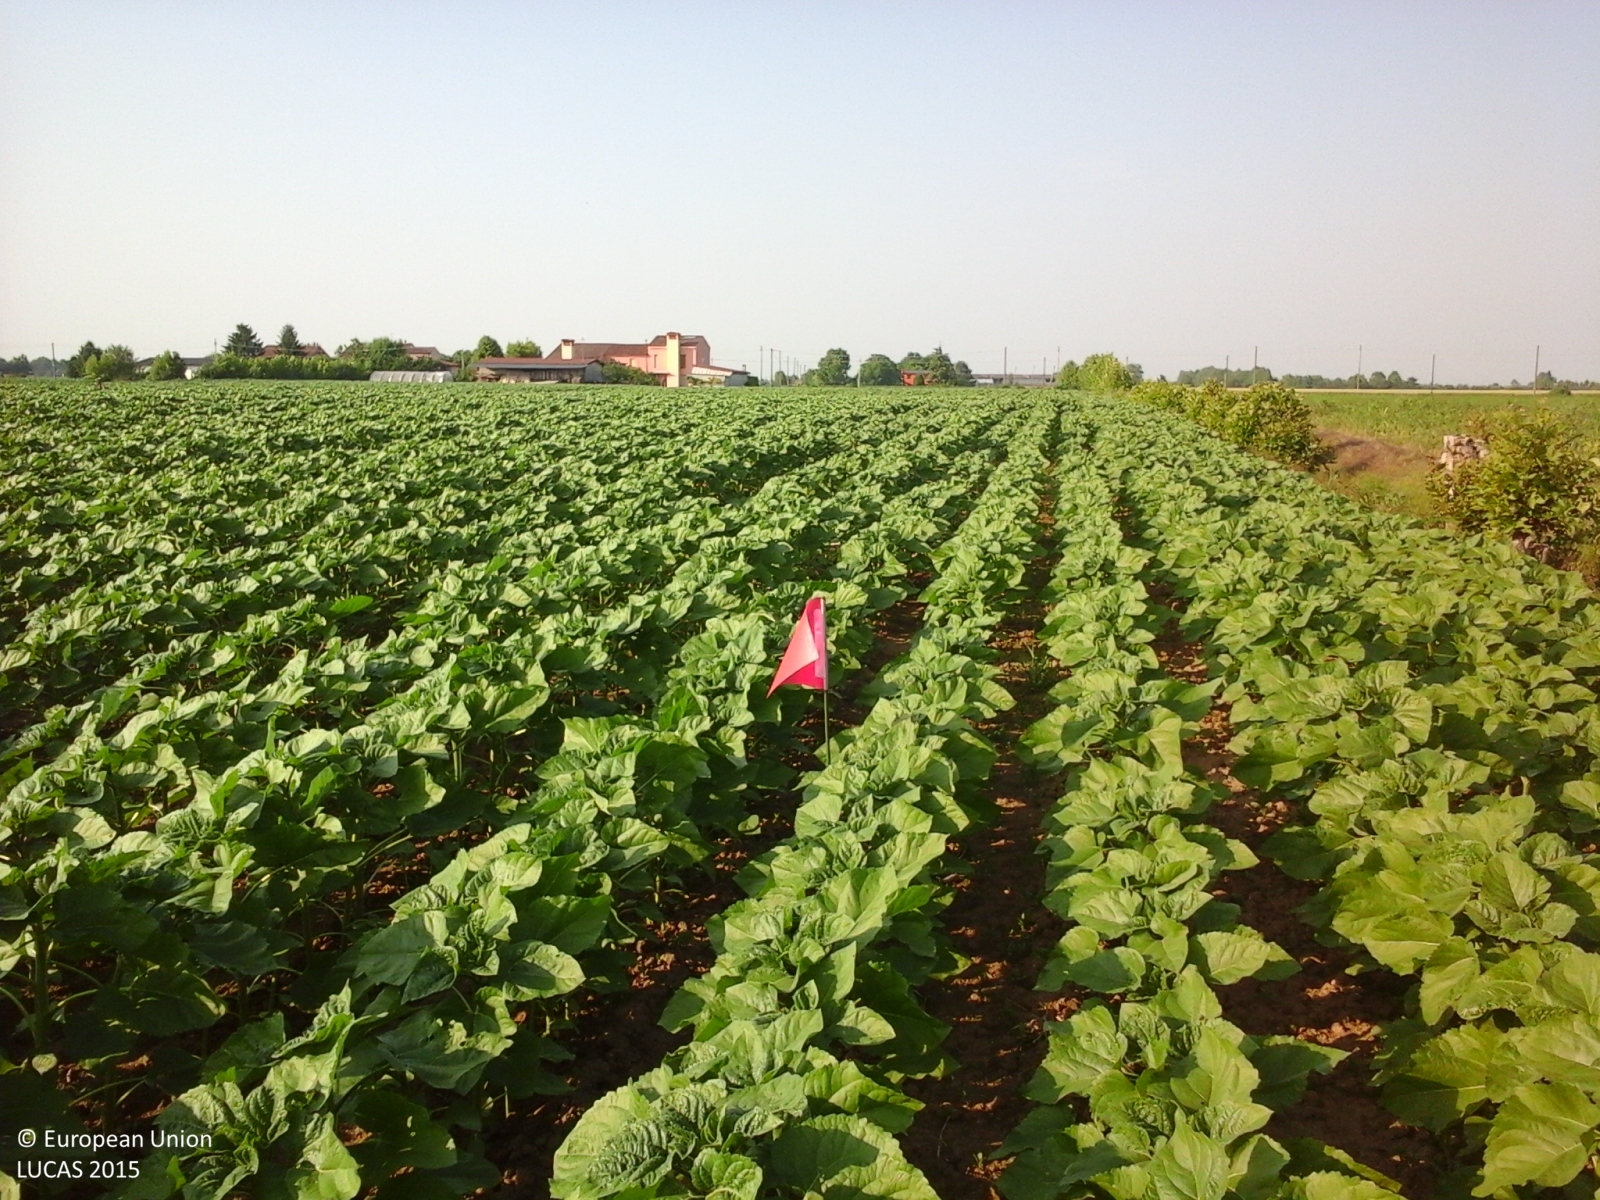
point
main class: Cropland
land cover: Sunflower
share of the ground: > 75 %
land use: Agriculture (excluding fallow land and kitchen gardens)
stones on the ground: < 10 %
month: May
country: IT
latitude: 45.2302
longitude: 10.9027
